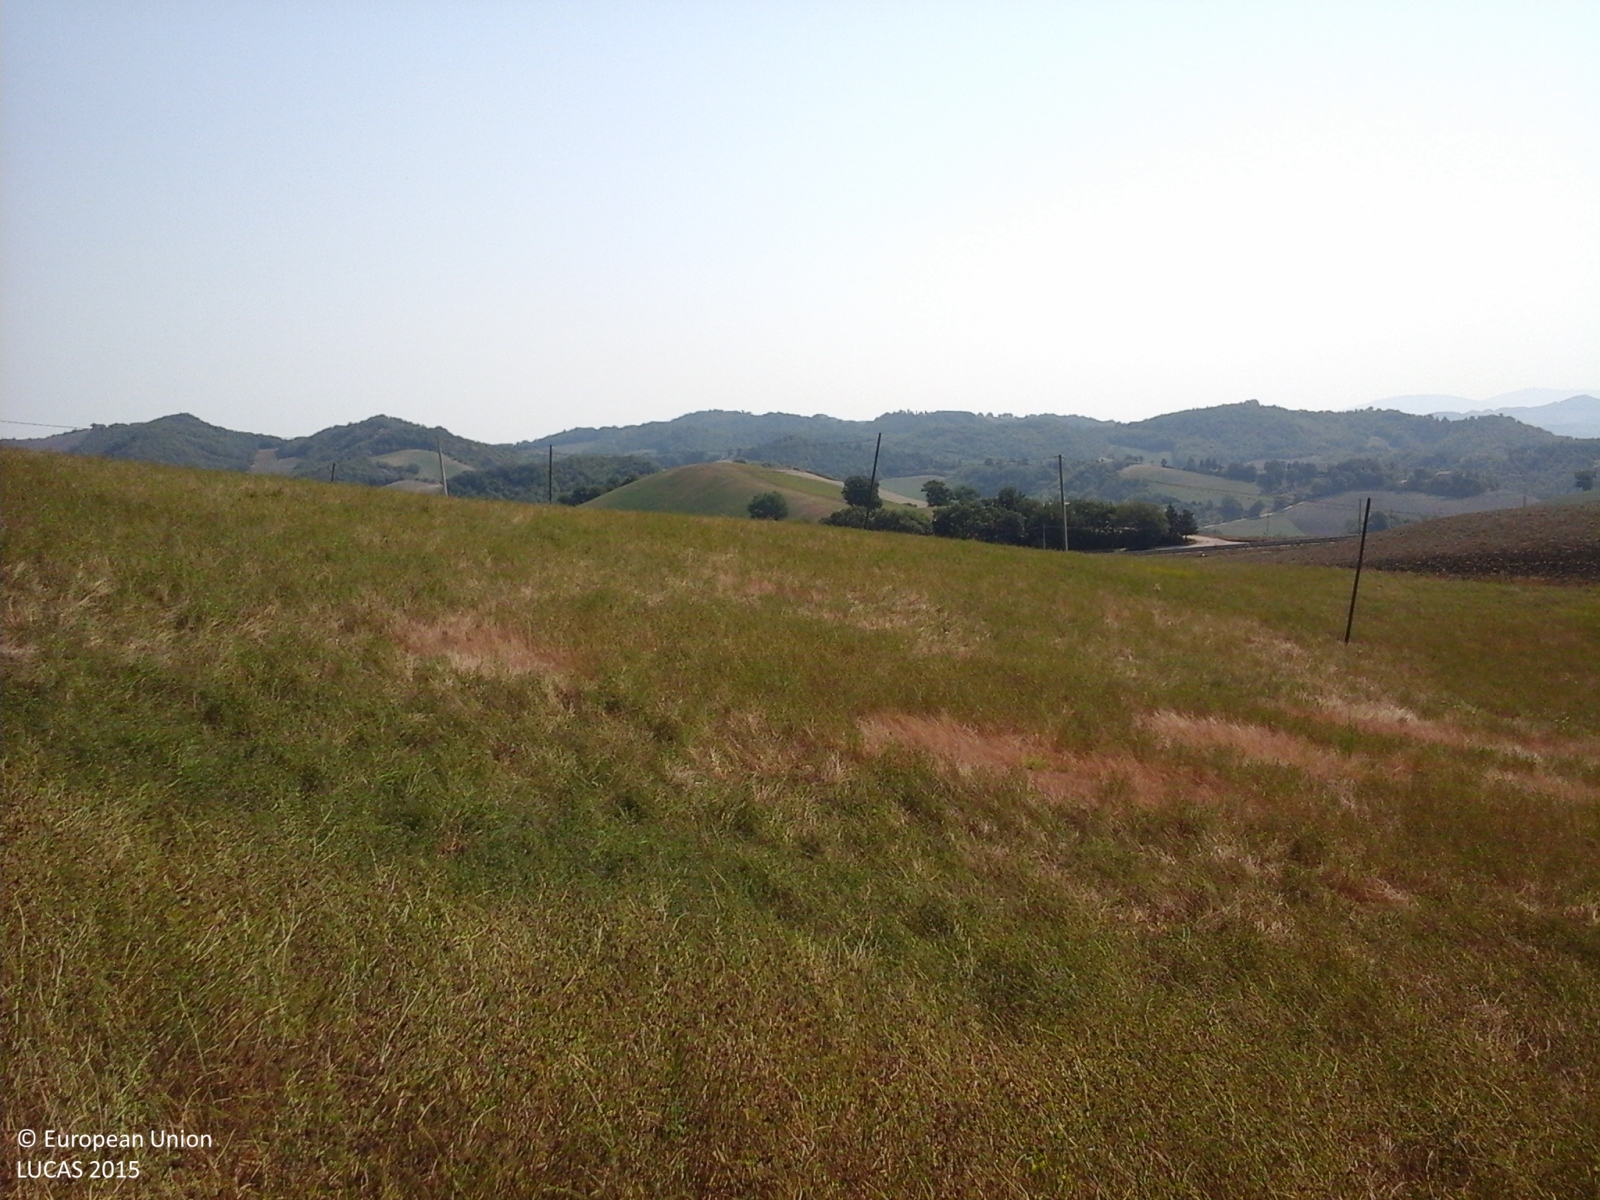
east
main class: Cropland
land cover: Lucerne
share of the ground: > 75 %
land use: Agriculture (excluding fallow land and kitchen gardens)
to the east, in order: Lucerne; Electric lines; Lucerne; Electric lines; Grass margins; Paved roads, cycling and walking lanes; Durum wheat
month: August
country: IT
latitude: 43.6902
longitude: 12.4380
